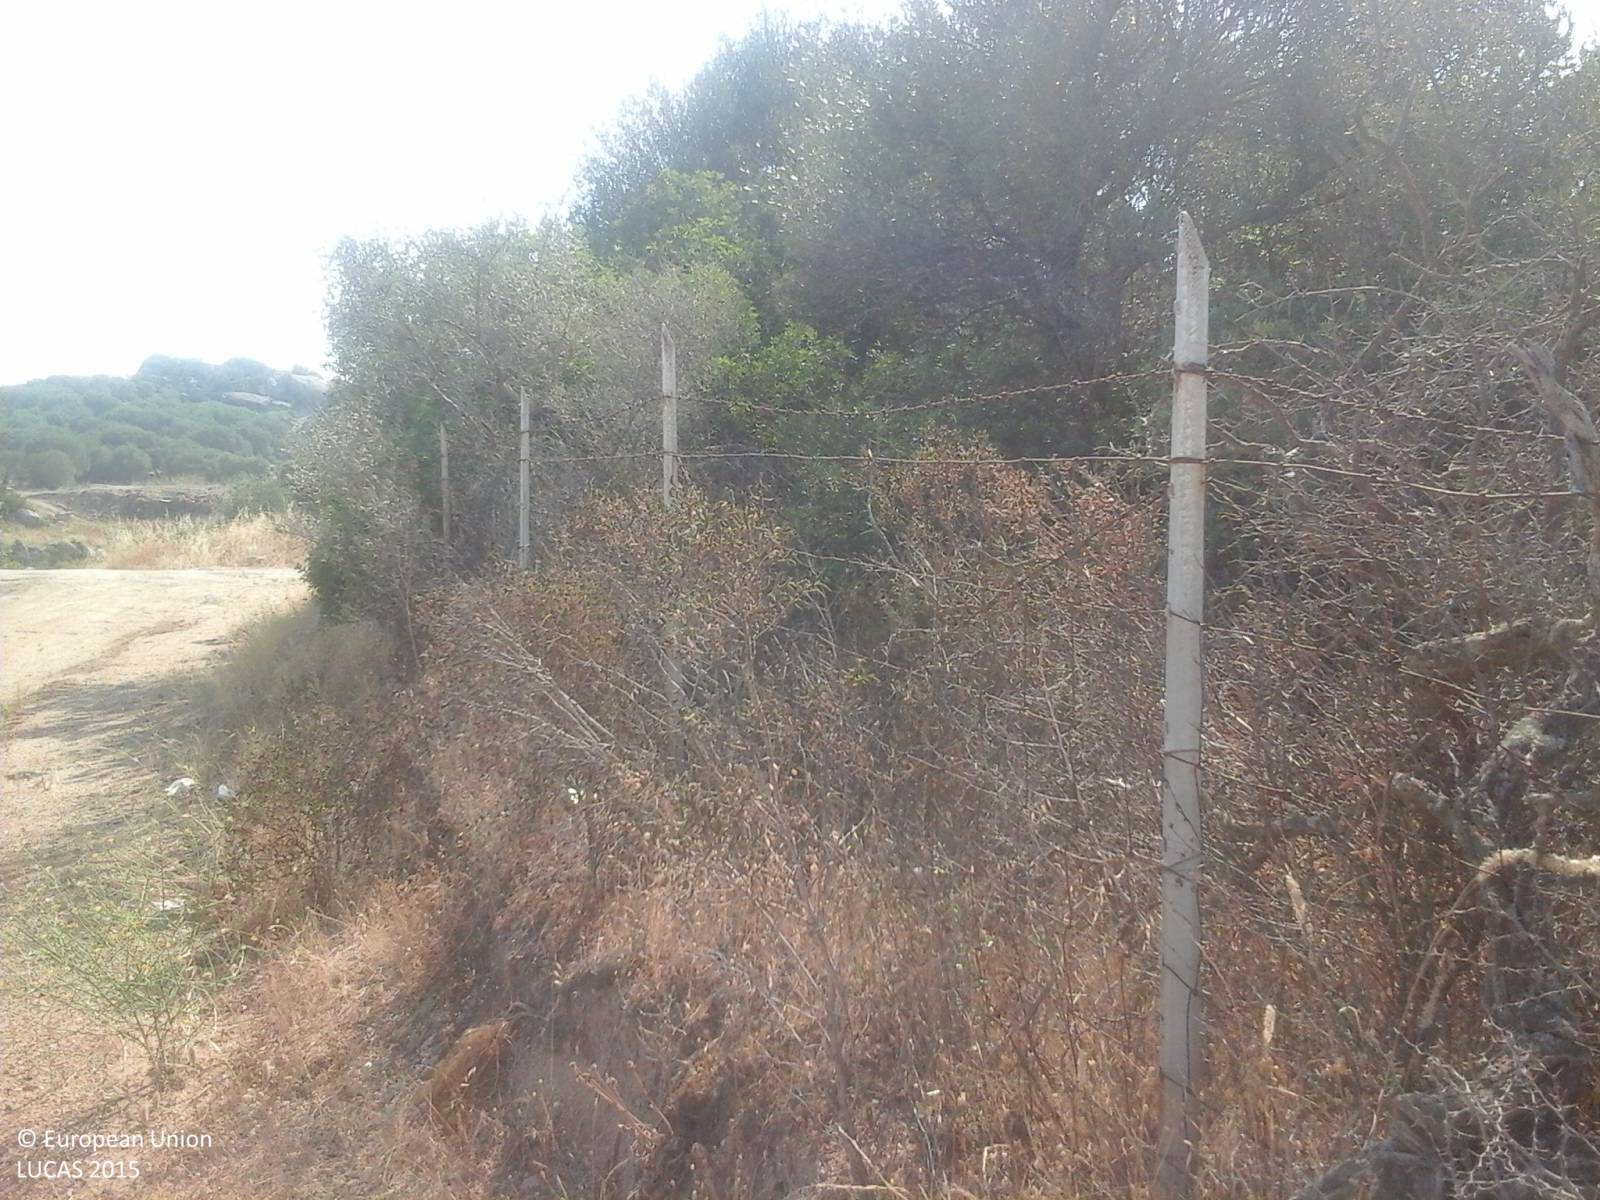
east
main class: Shrubland
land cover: Shrubland with sparse tree cover
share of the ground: > 75 %
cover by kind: shrubs 95 %, broadleaved forest trees 5 %
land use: Agriculture (excluding fallow land and kitchen gardens)
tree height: < 5 m
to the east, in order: Shrubland with sparse tree cover; Grassland without tree/shrub cover; Shrubland with sparse tree cover; Grassland without tree/shrub cover; Broadleaved woodland; Rivers and streams; Sand; Rocks and stones; Rivers and streams; Broadleaved woodland
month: July
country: IT
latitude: 40.8812
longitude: 9.4685
